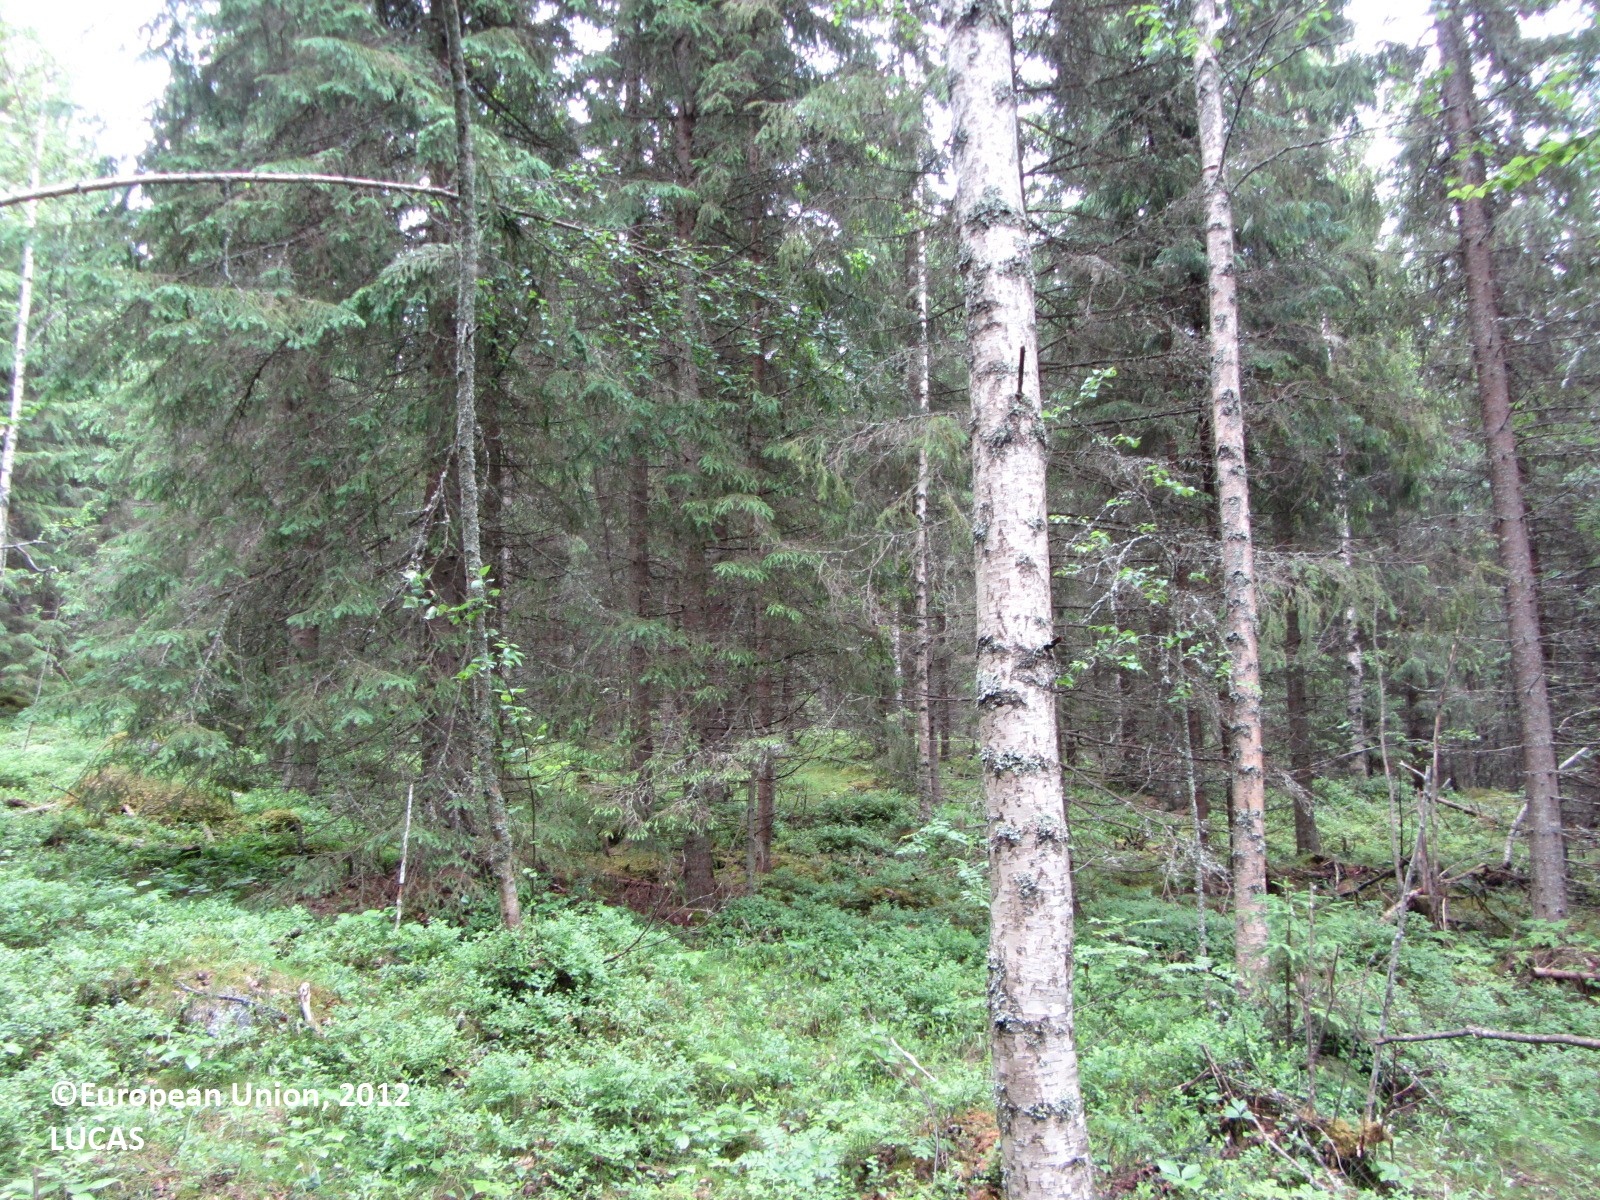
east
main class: Woodland
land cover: Spruce dominated mixed woodland
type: boreal forest
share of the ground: 50 - 75 %
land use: Forestry
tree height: > 5 m
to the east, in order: Spruce dominated mixed woodland; Grassland with sparse tree/shrub cover; Spruce dominated mixed woodland; Fences; Other mixed woodland; Fences; Other leguminous and mixtures for fodder
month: July
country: FI
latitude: 62.9367
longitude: 25.0502
